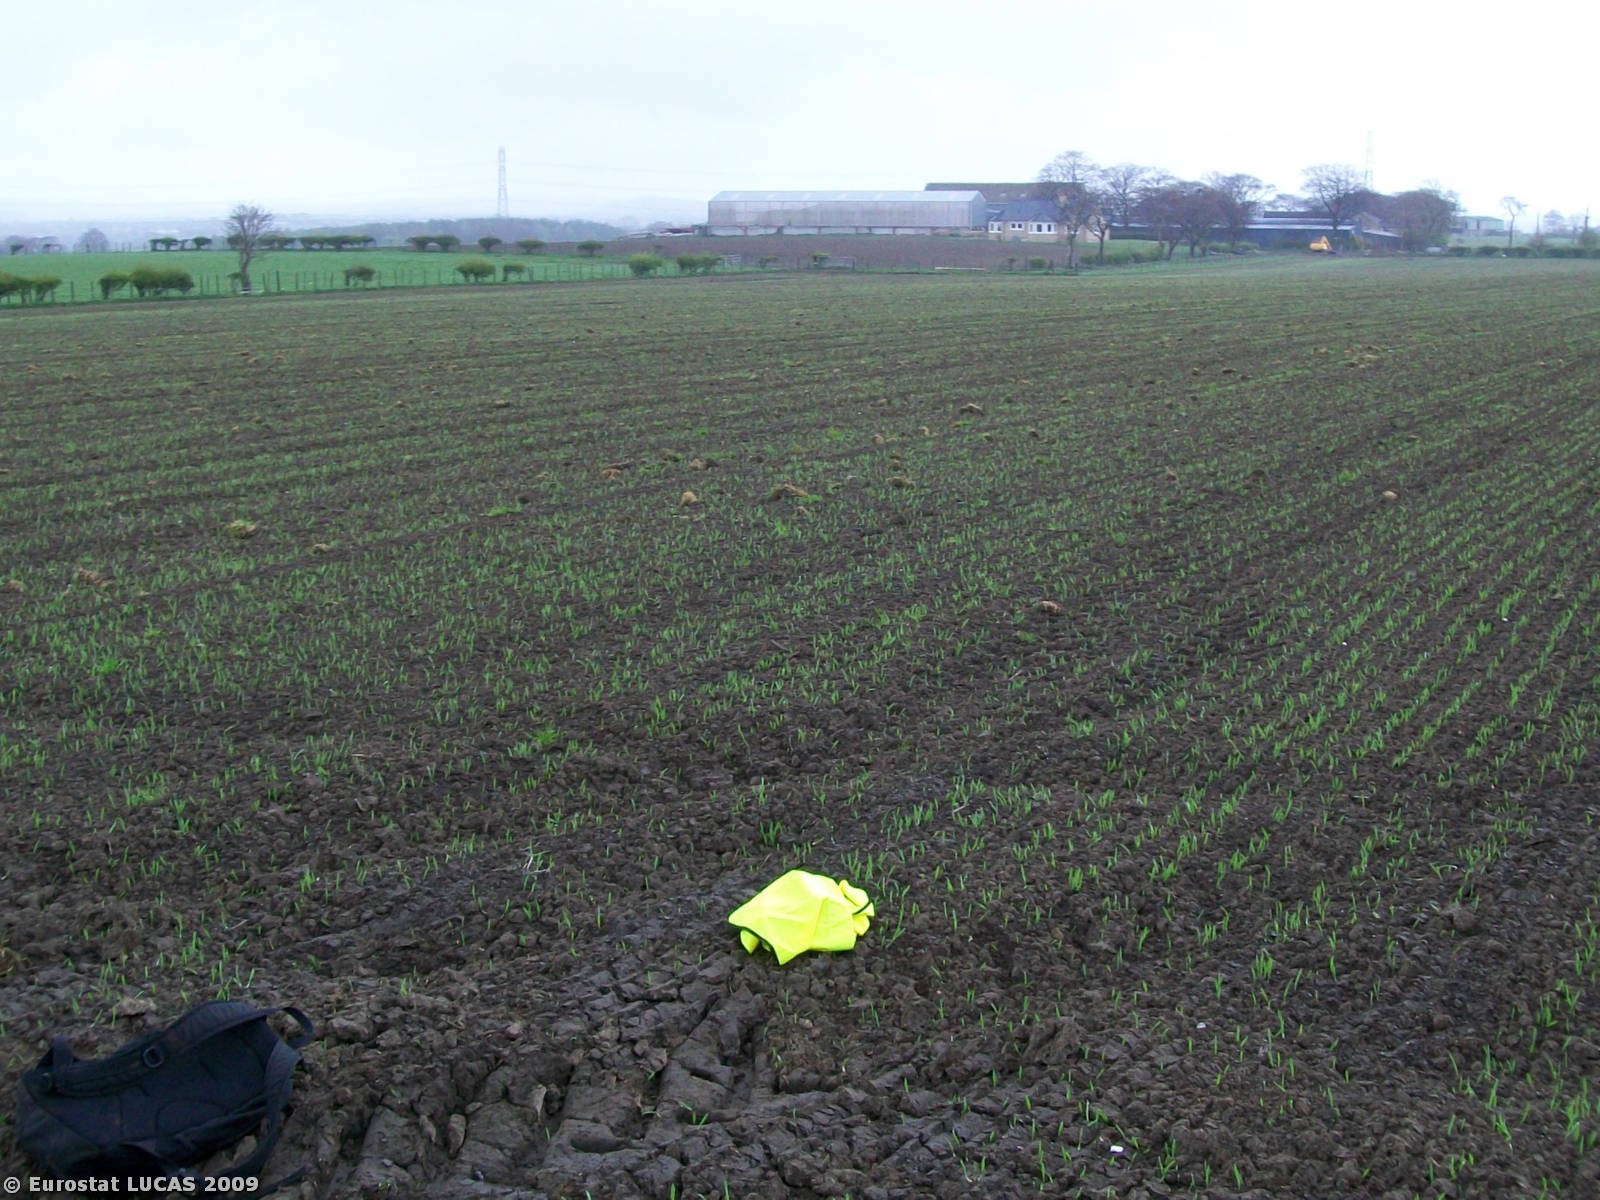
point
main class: Cropland
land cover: Barley
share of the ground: > 75 %
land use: Agriculture (excluding fallow land and kitchen gardens)
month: April
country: GB
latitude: 55.8562
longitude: -3.6437
